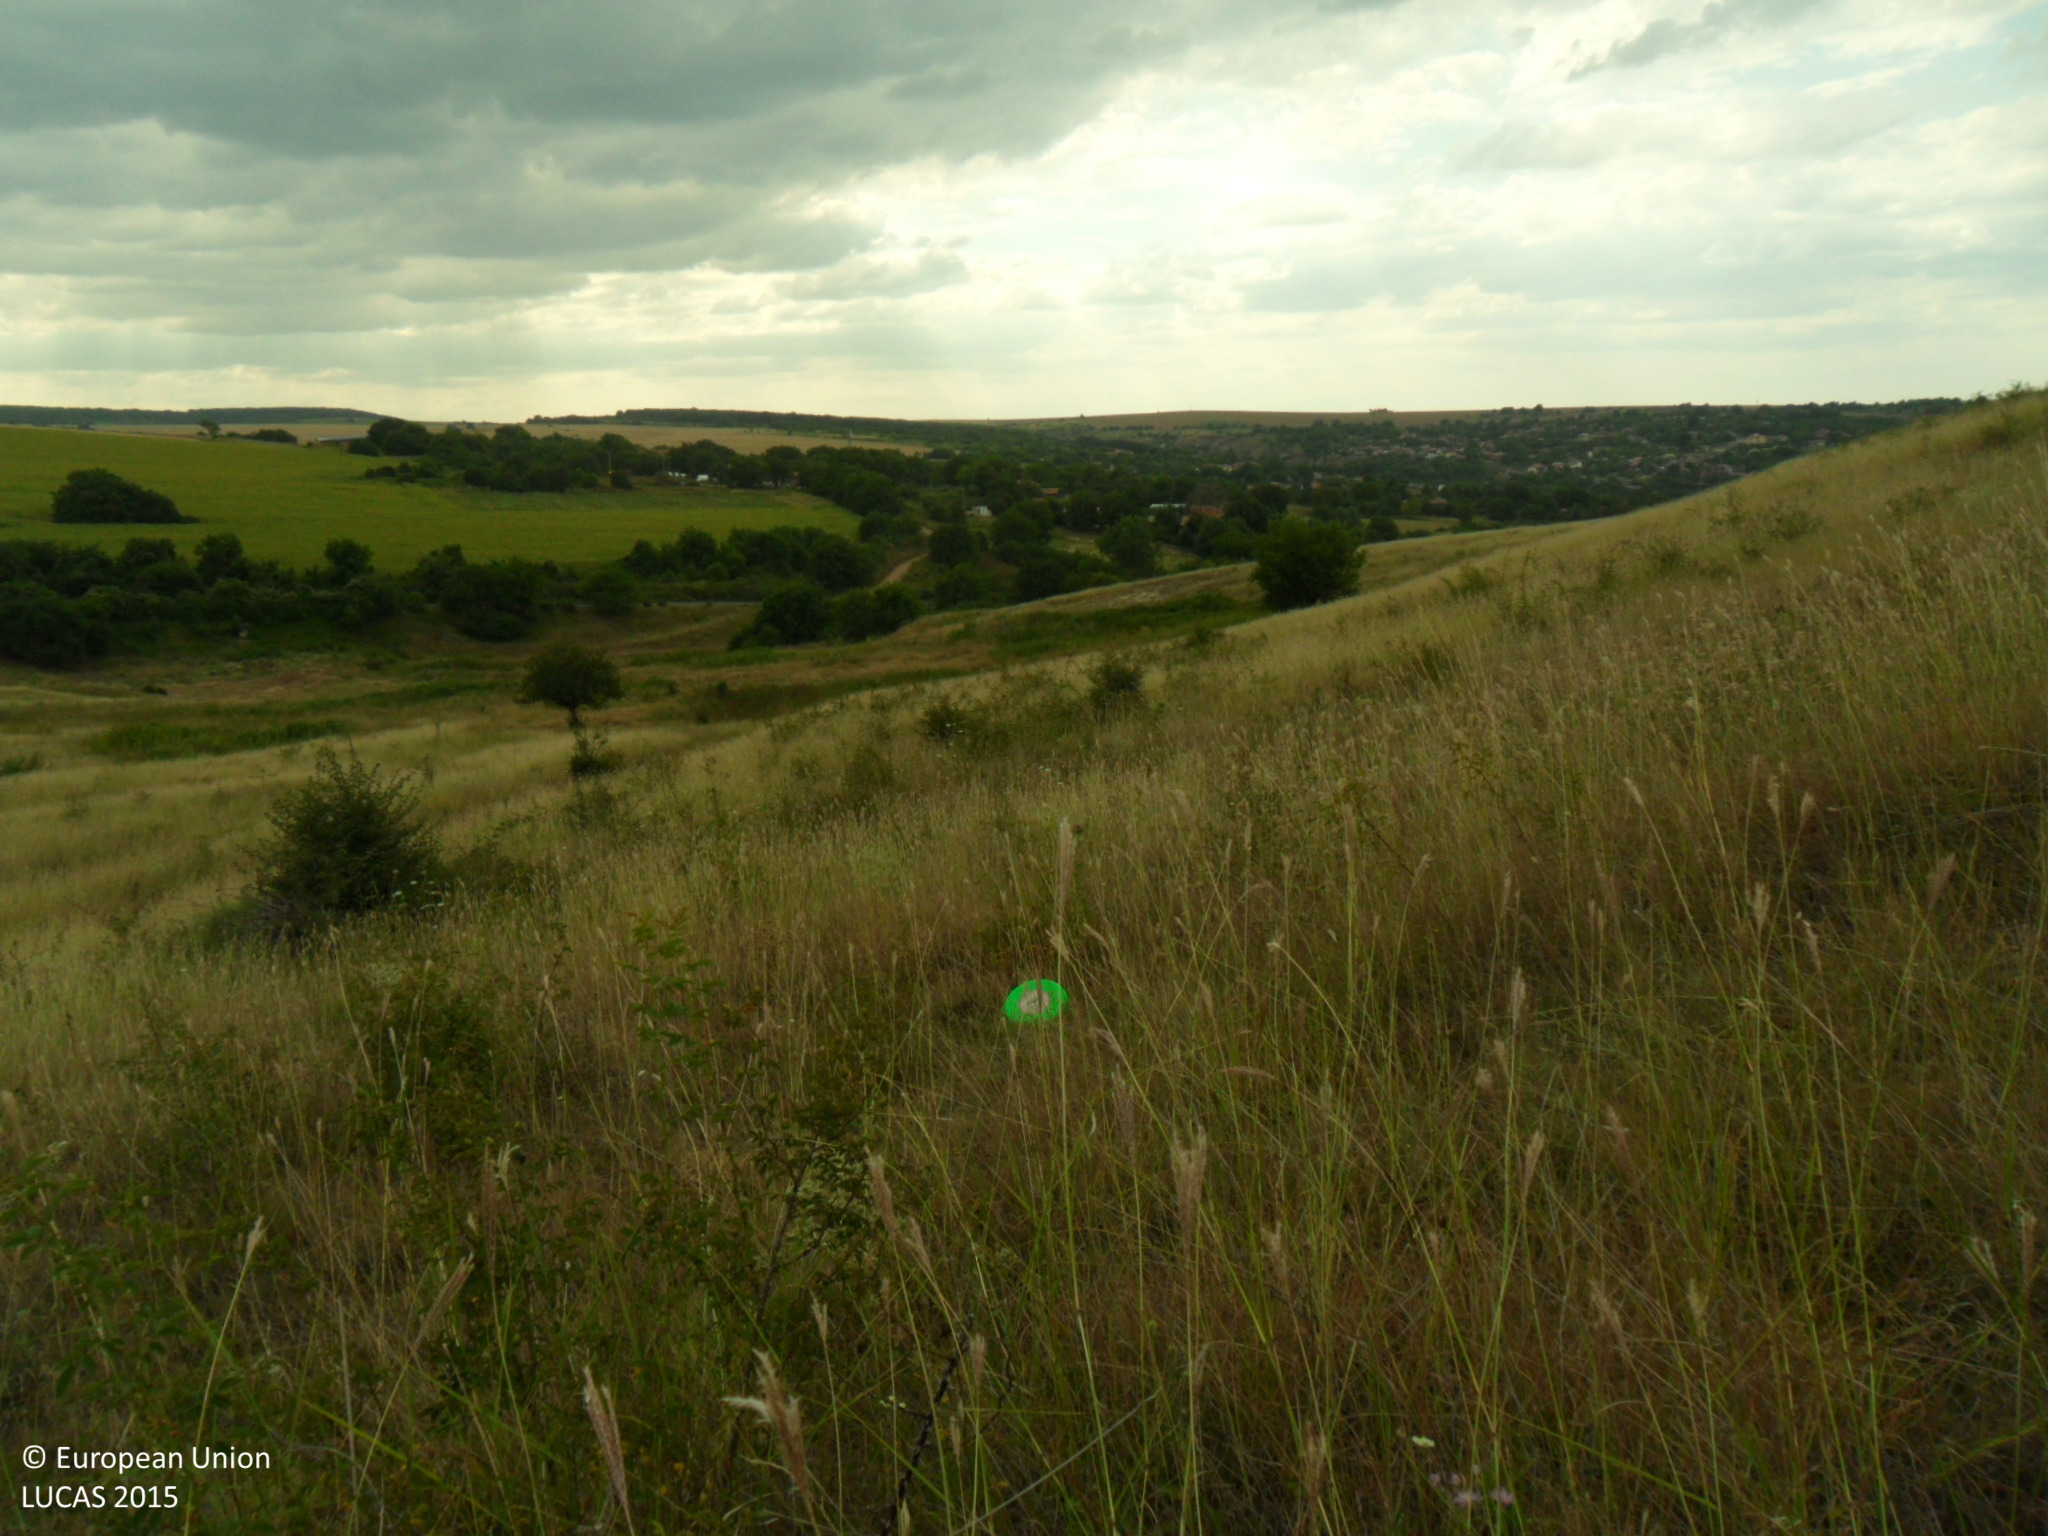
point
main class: Grassland
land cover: Grassland with sparse tree/shrub cover
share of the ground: > 75 %
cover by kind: herbaceous plants 90 %, broadleaved forest trees 5 %, shrubs 5 %
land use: Agriculture (excluding fallow land and kitchen gardens)
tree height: < 5 m
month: August
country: BG
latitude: 43.4822
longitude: 26.5876
